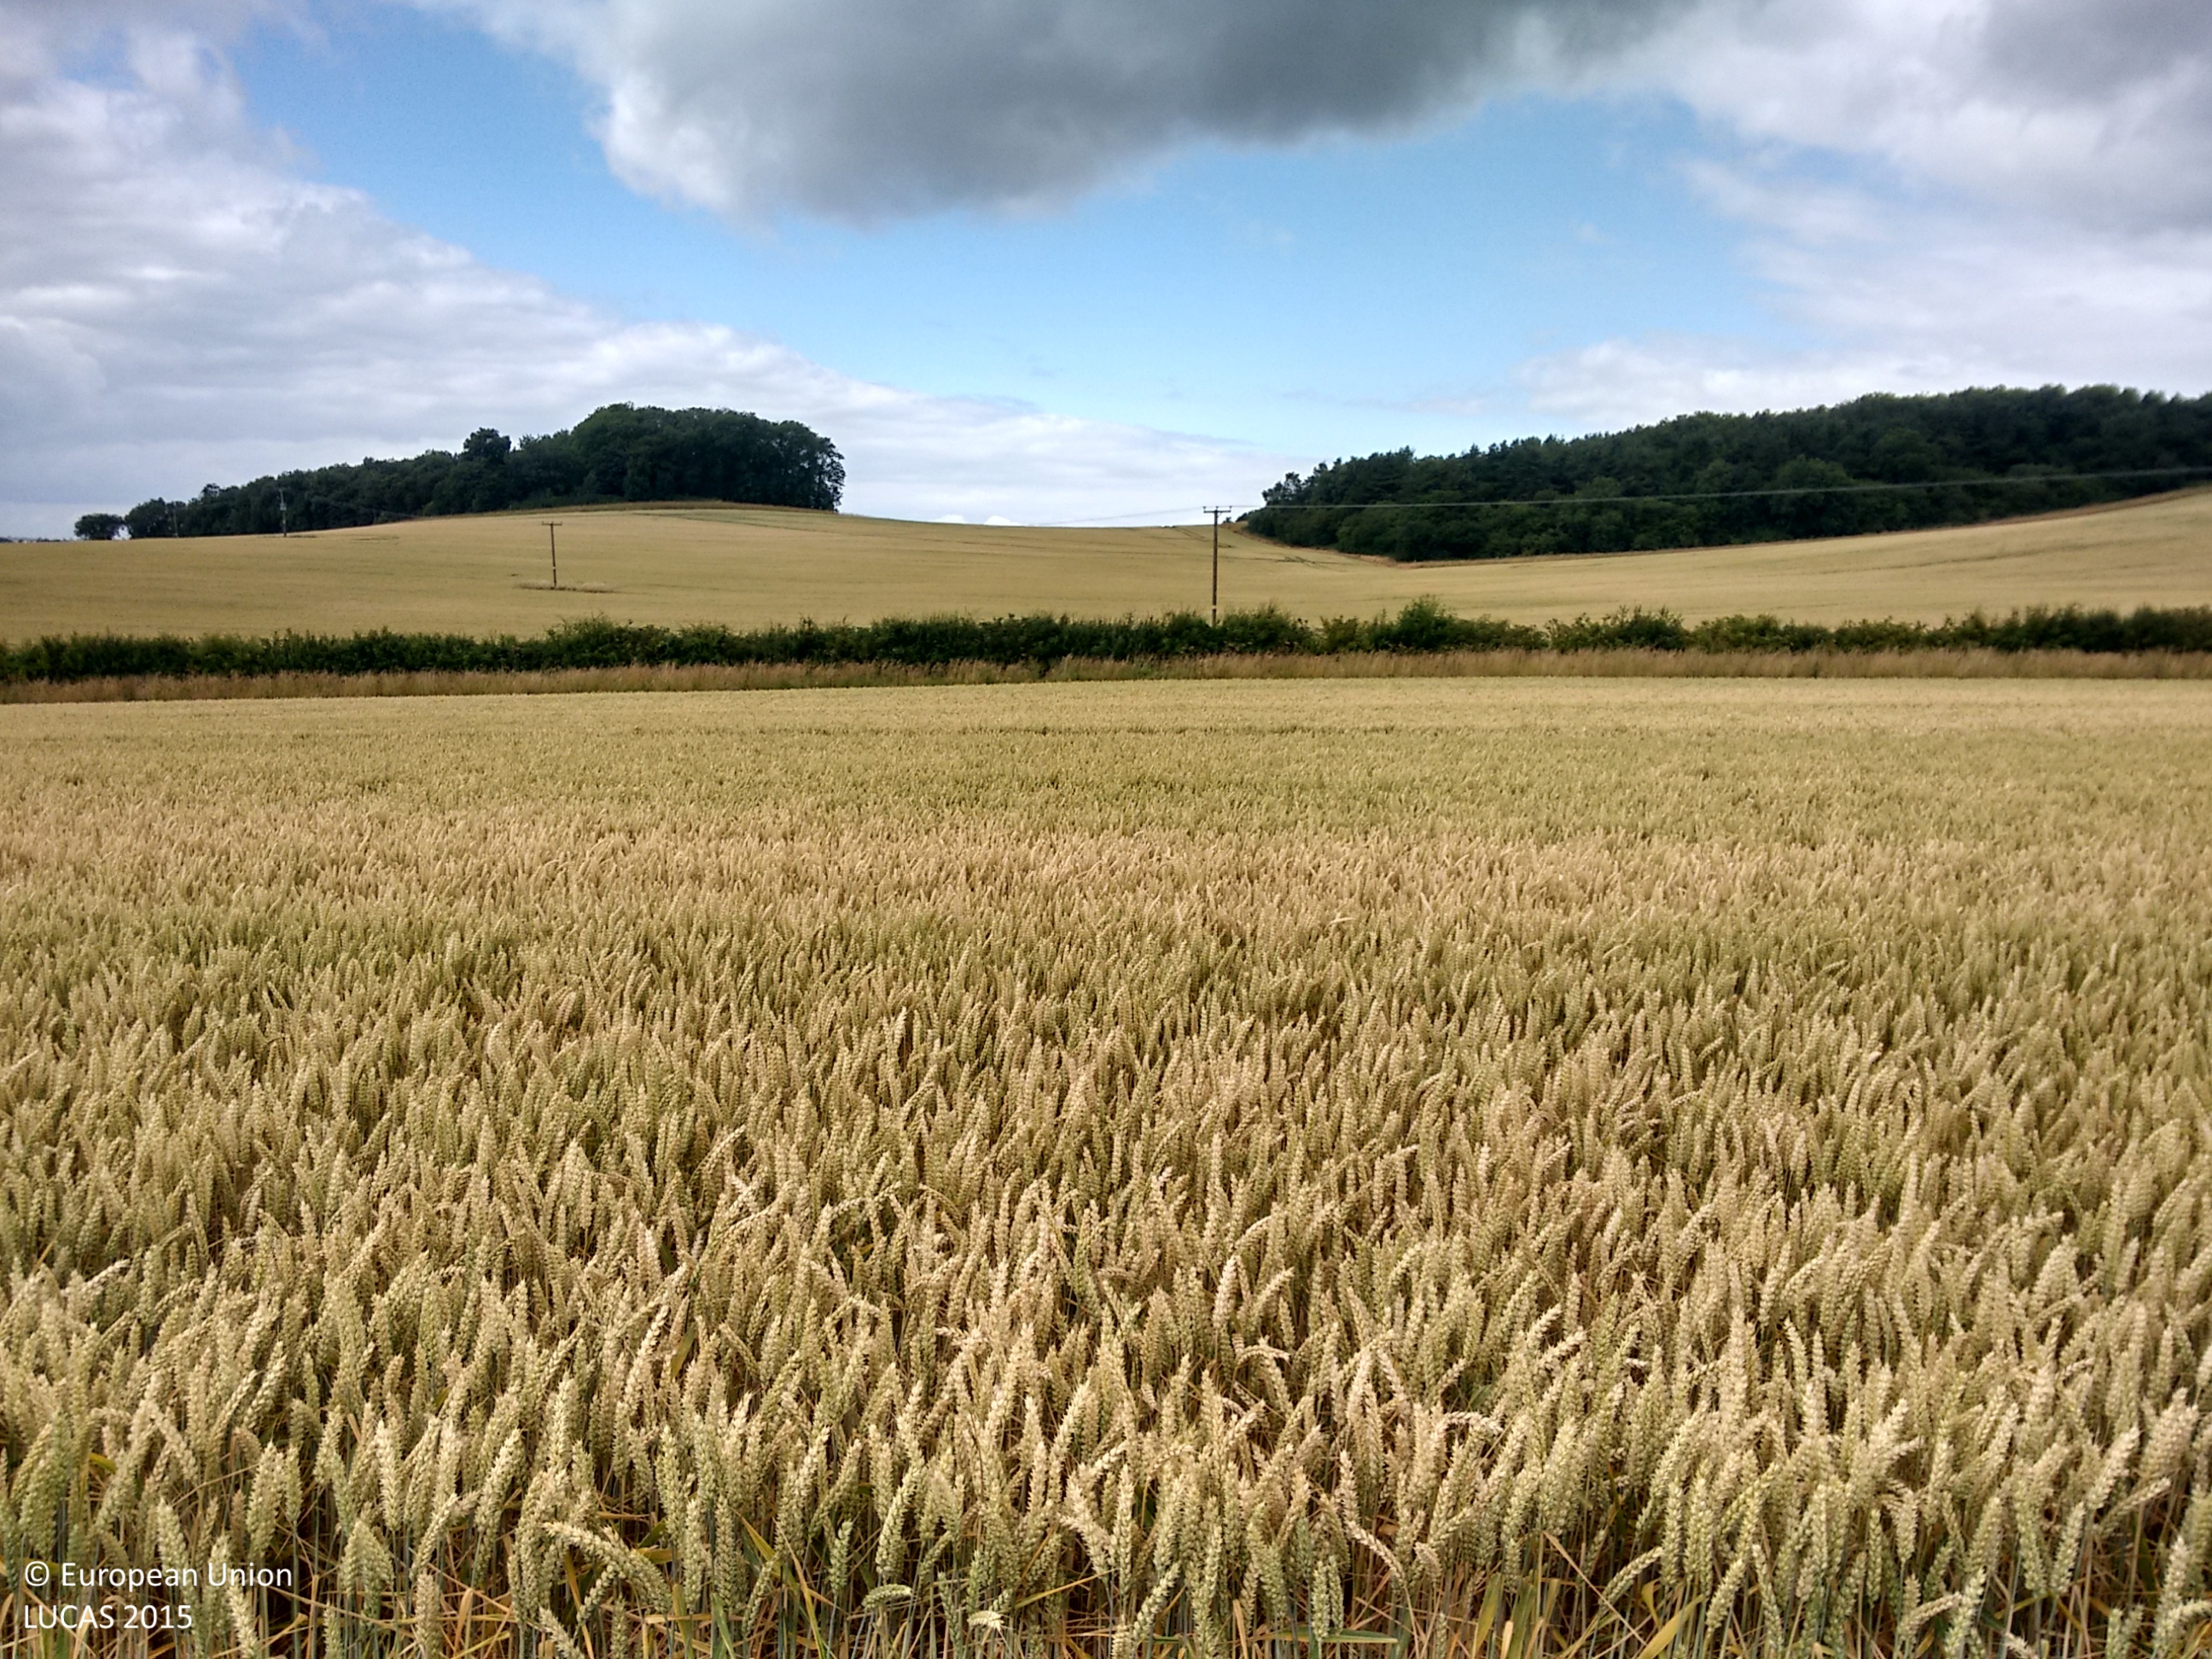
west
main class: Cropland
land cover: Common wheat
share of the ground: > 75 %
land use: Agriculture (excluding fallow land and kitchen gardens)
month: July
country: GB
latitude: 53.1351
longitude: -1.0001
